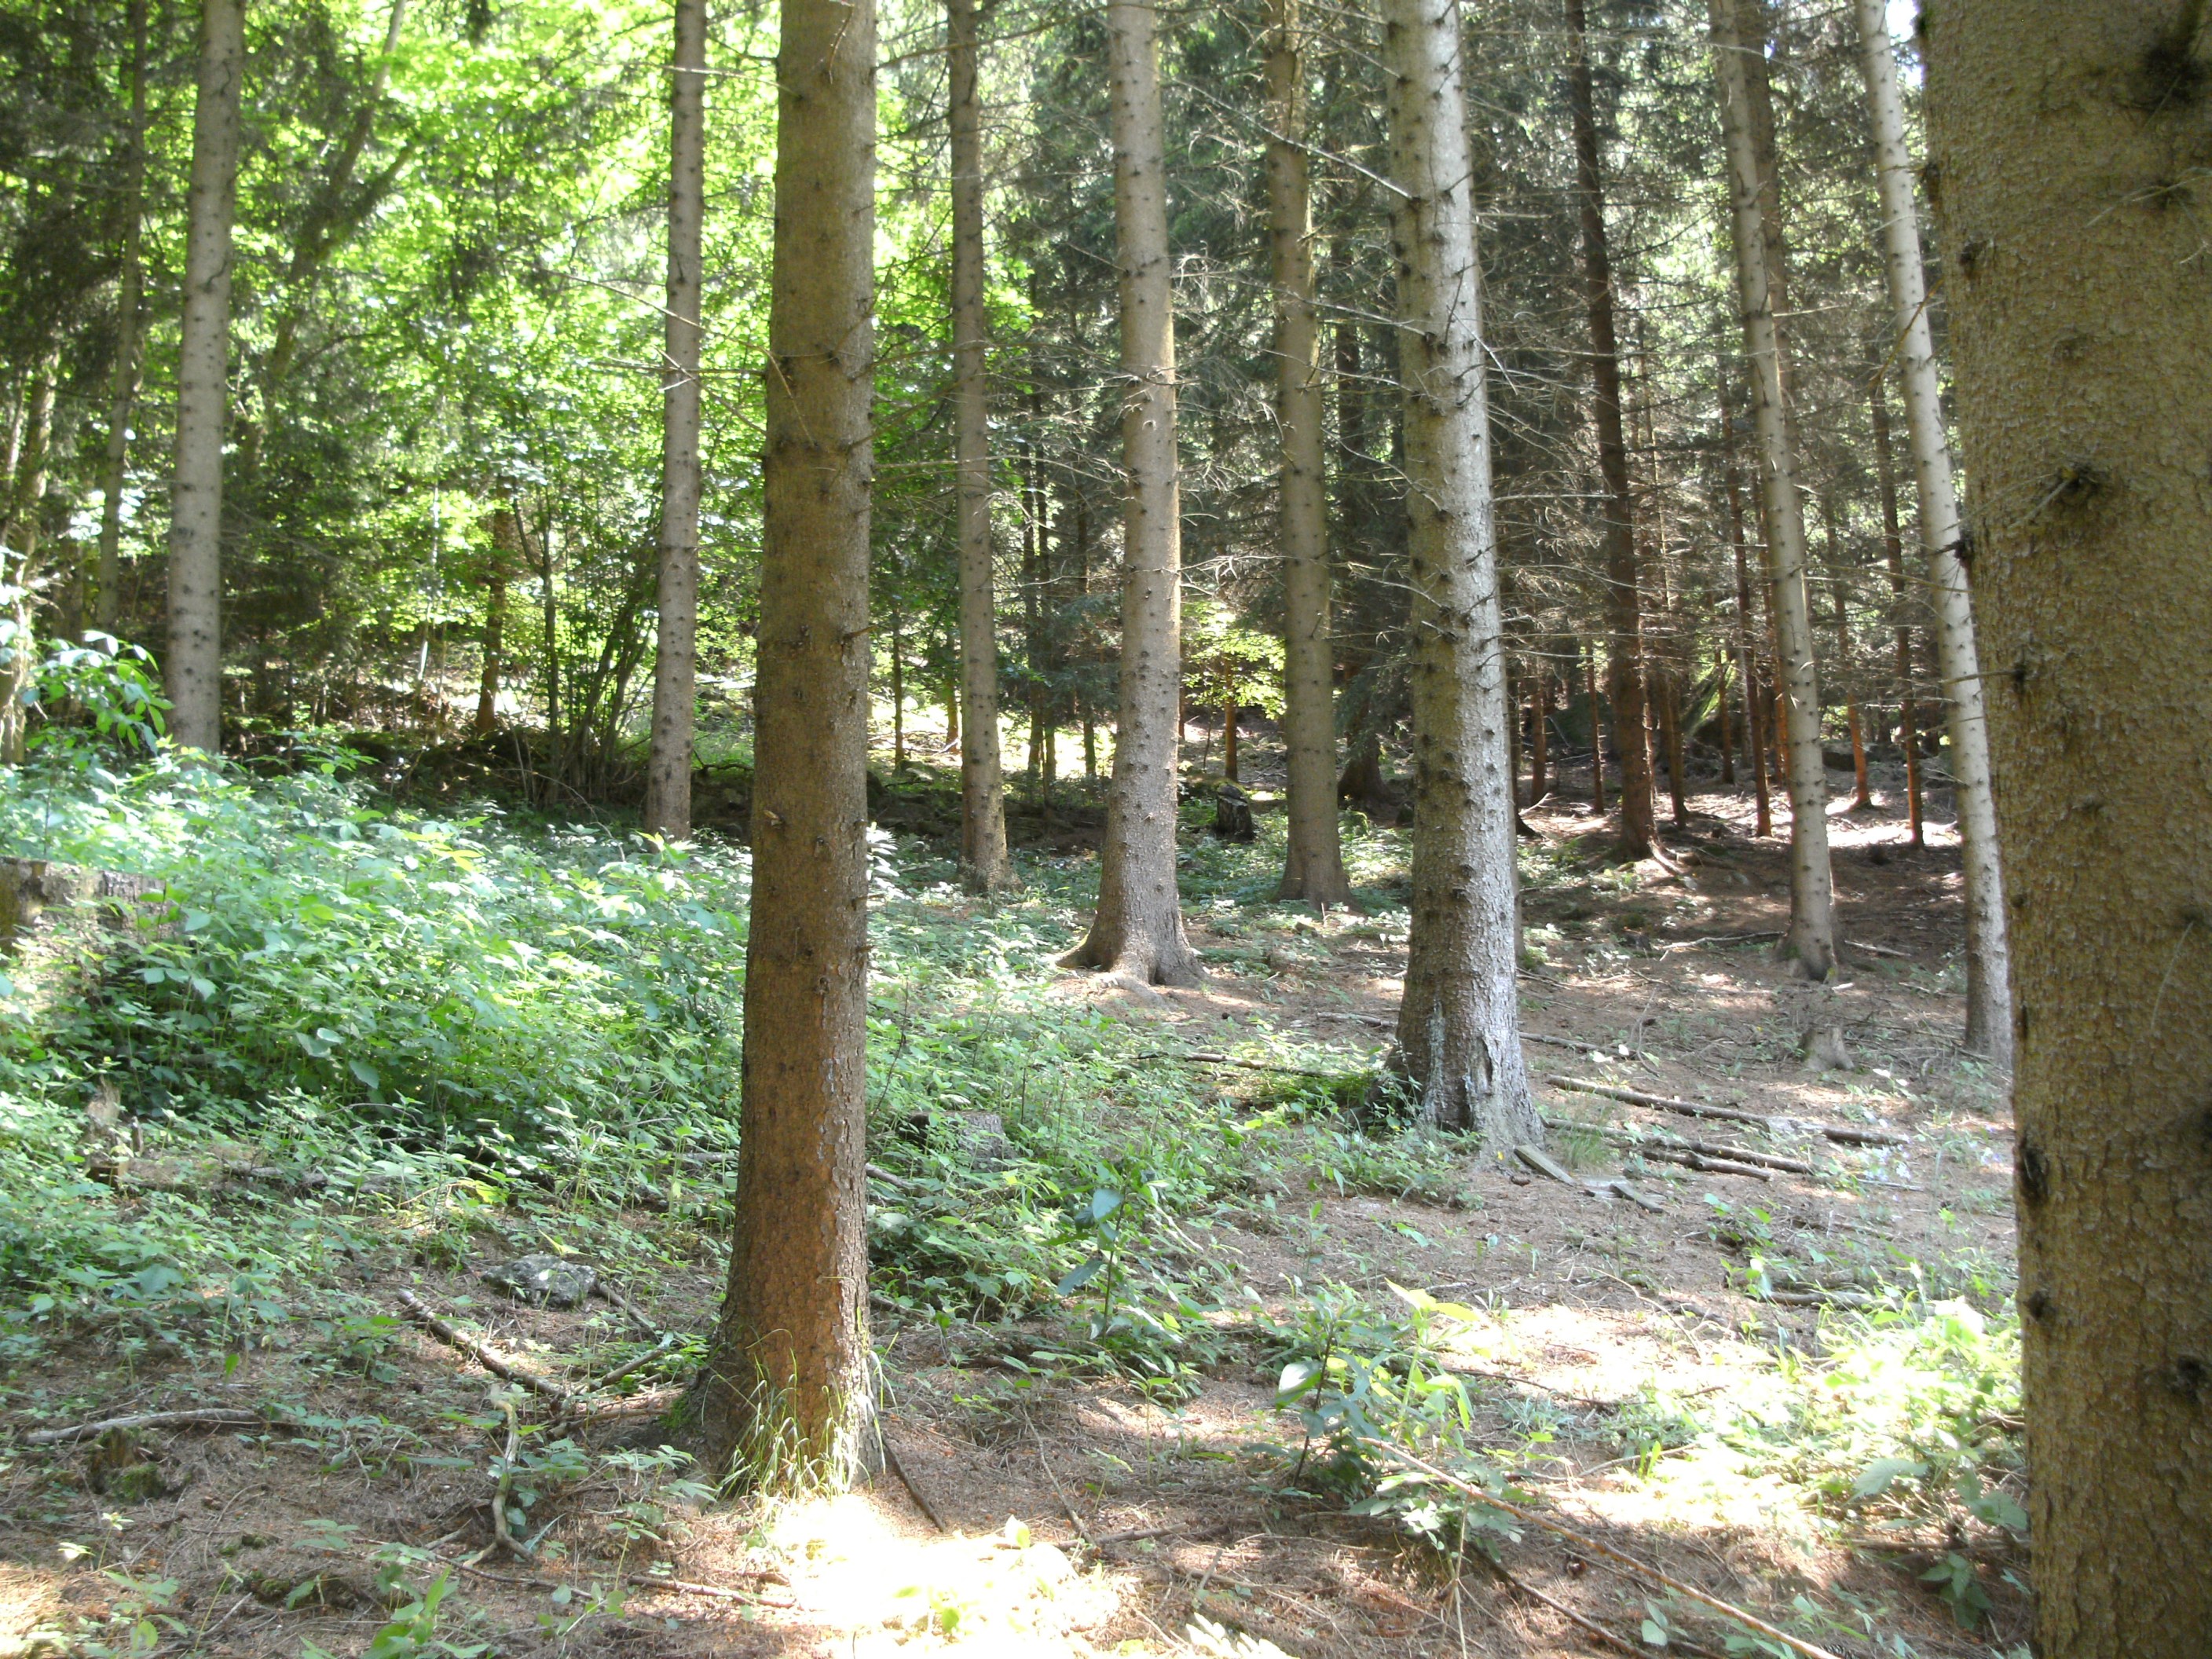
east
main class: Woodland
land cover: Spruce dominated coniferous woodland
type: hemiboreal forest and nemoral coniferous forest and mixed broadleaved-coniferous forest
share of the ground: 50 - 75 %
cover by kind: coniferous forest trees 80 %, herbaceous plants 15 %, shrubs 5 %
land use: Forestry
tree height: > 5 m
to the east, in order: Spruce dominated coniferous woodland; Spruce dominated mixed woodland; Spruce dominated coniferous woodland; Spruce dominated mixed woodland; Tracks; Broadleaved woodland; Spruce dominated mixed woodland; Spruce dominated coniferous woodland; Tracks; Spruce dominated mixed woodland; Paved roads, cycling and walking lanes; Other mixed woodland; Grassland without tree/shrub cover; Mixed cereals for fodder
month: June
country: AT
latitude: 48.4497
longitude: 14.2050
